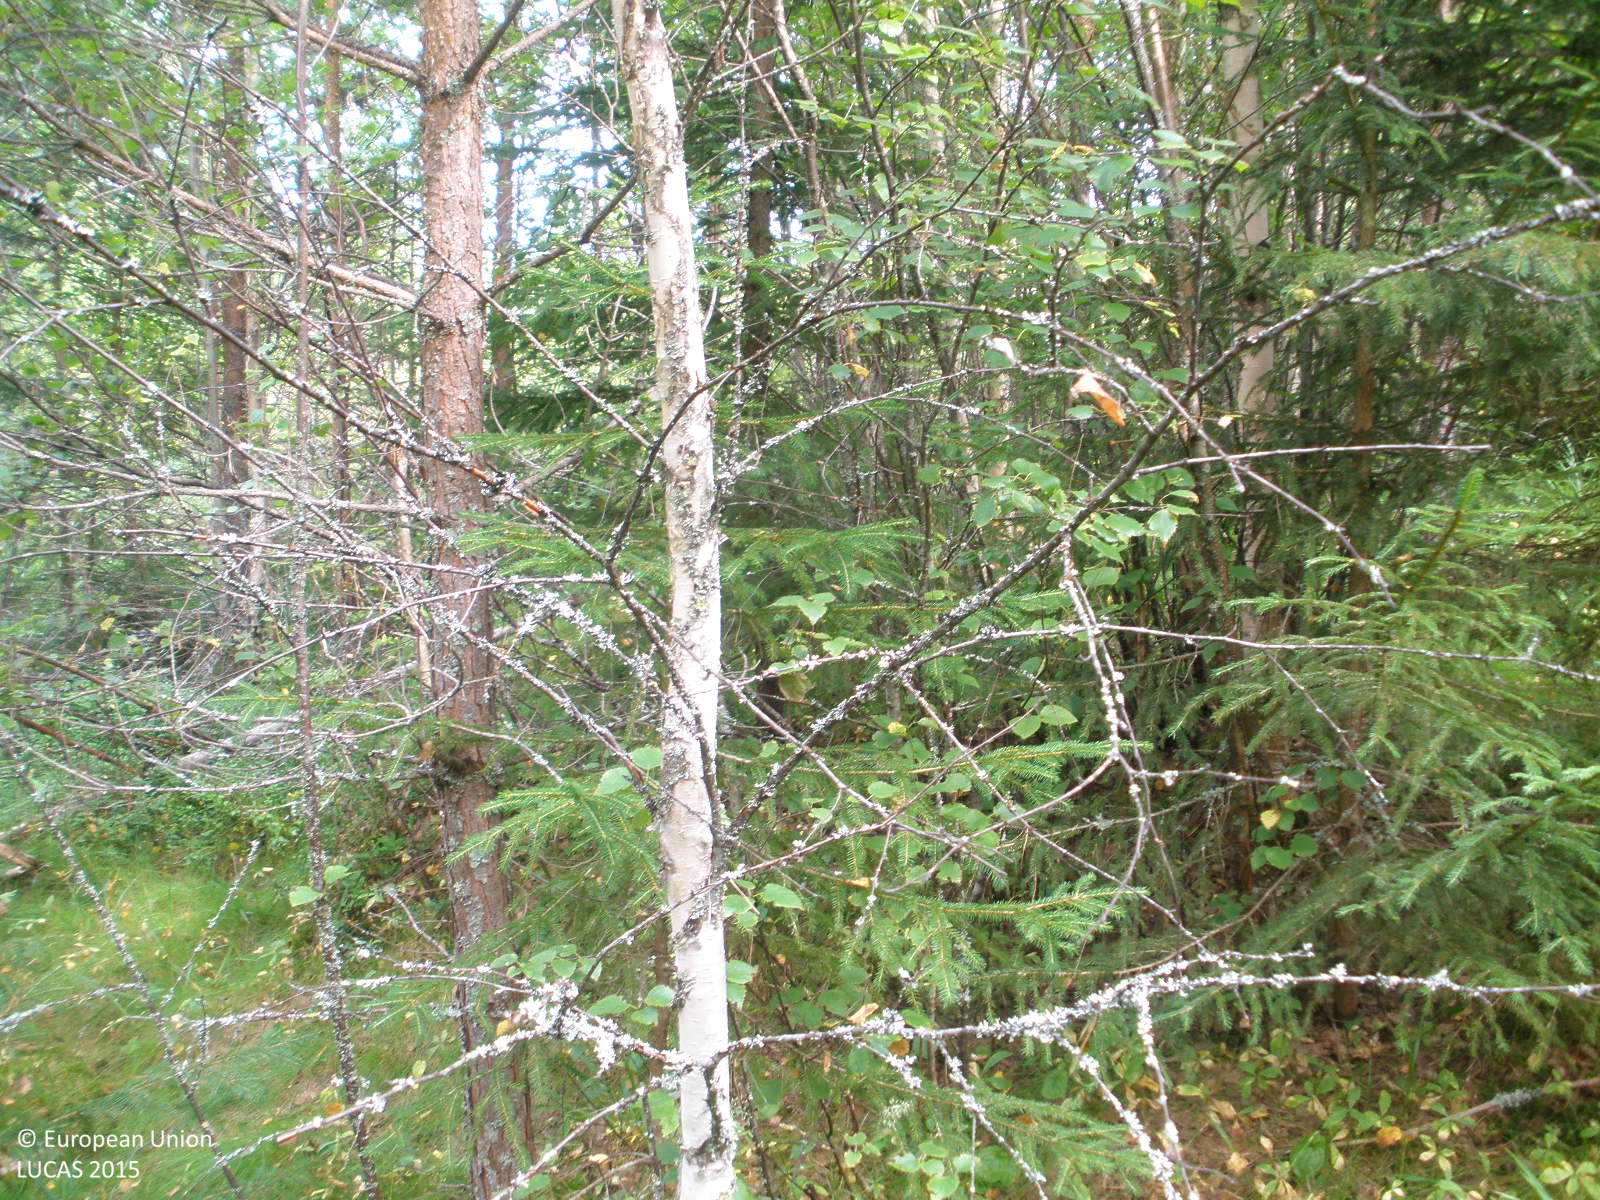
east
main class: Woodland
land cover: Pine dominated mixed woodland
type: boreal forest
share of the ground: 50 - 75 %
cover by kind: coniferous forest trees 40 %, broadleaved forest trees 25 %, herbaceous plants 25 %, shrubs 5 %, lichens and mosses 5 %
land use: Forestry
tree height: > 5 m
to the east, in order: Pine dominated mixed woodland; Spruce dominated mixed woodland; Ditches and canals; Spruce dominated mixed woodland; Paved roads, cycling and walking lanes; Grass margins; Spruce dominated mixed woodland; Tracks; Spruce dominated mixed woodland
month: August
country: FI
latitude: 60.7892
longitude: 24.4495
